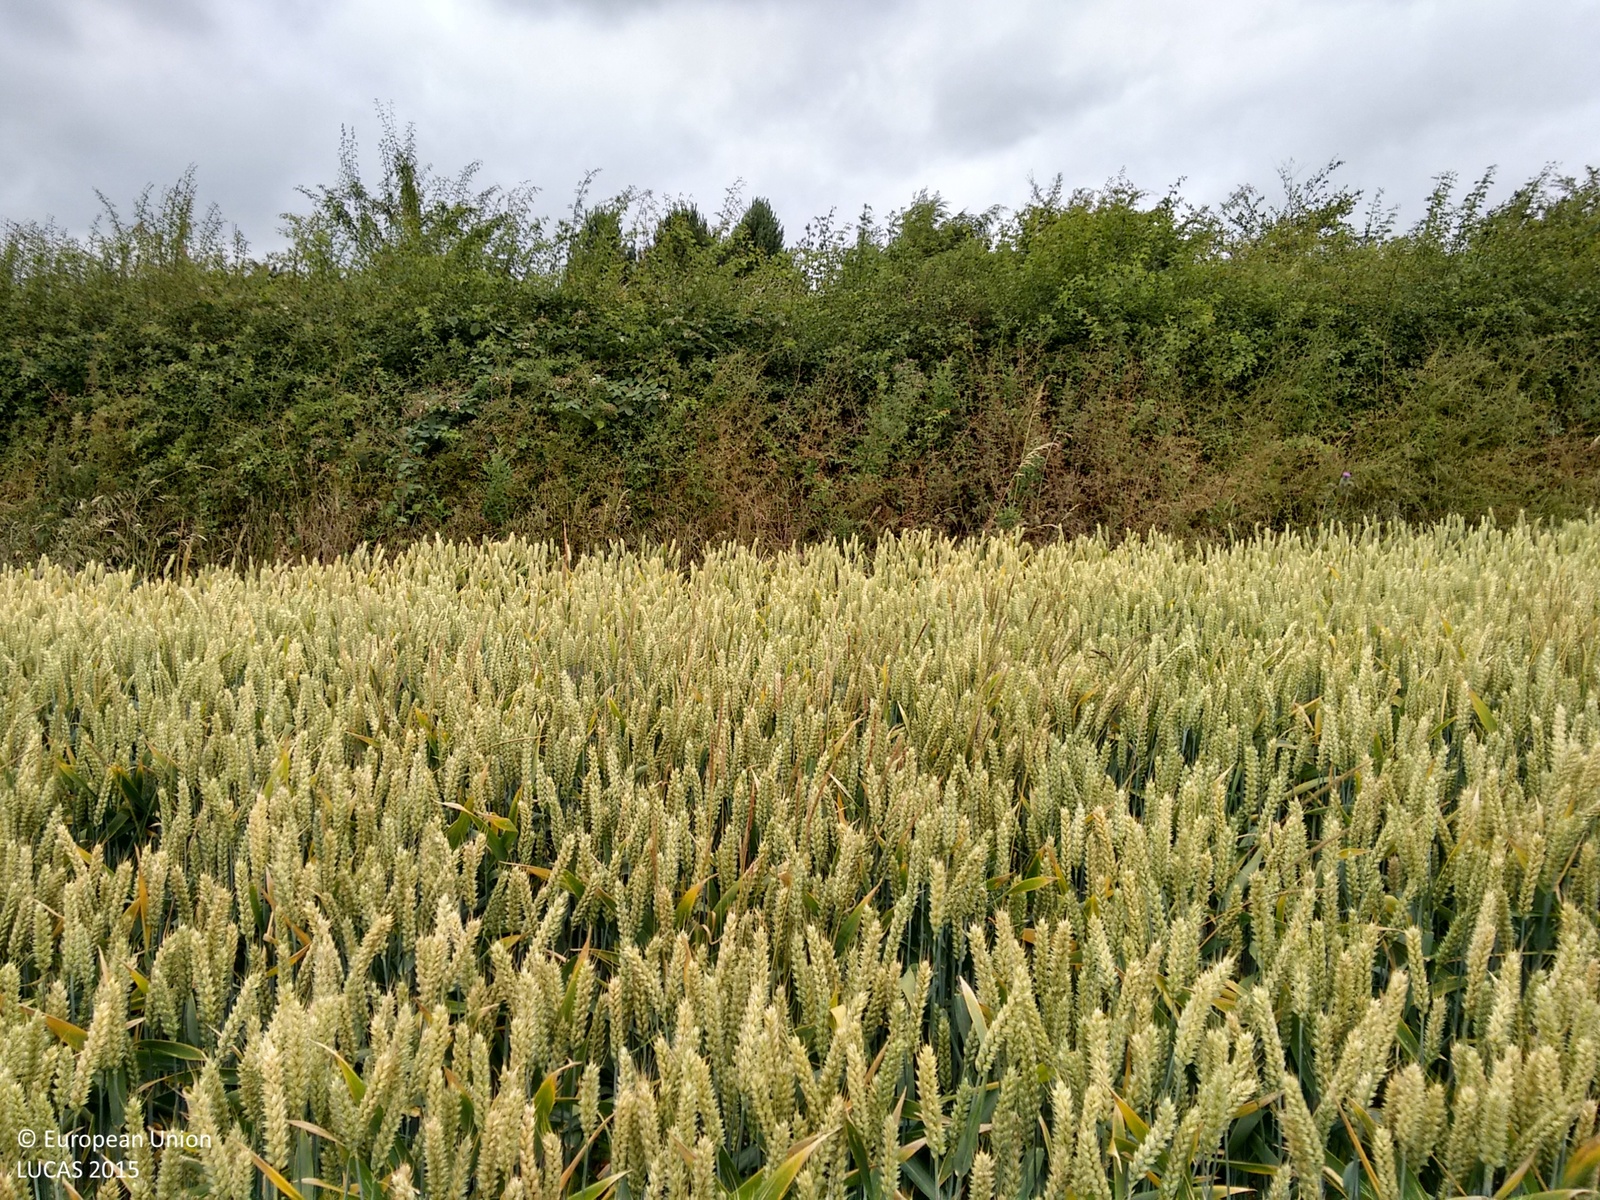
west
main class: Cropland
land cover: Common wheat
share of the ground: > 75 %
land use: Agriculture (excluding fallow land and kitchen gardens)
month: July
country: GB
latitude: 52.4530
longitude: -0.9176
